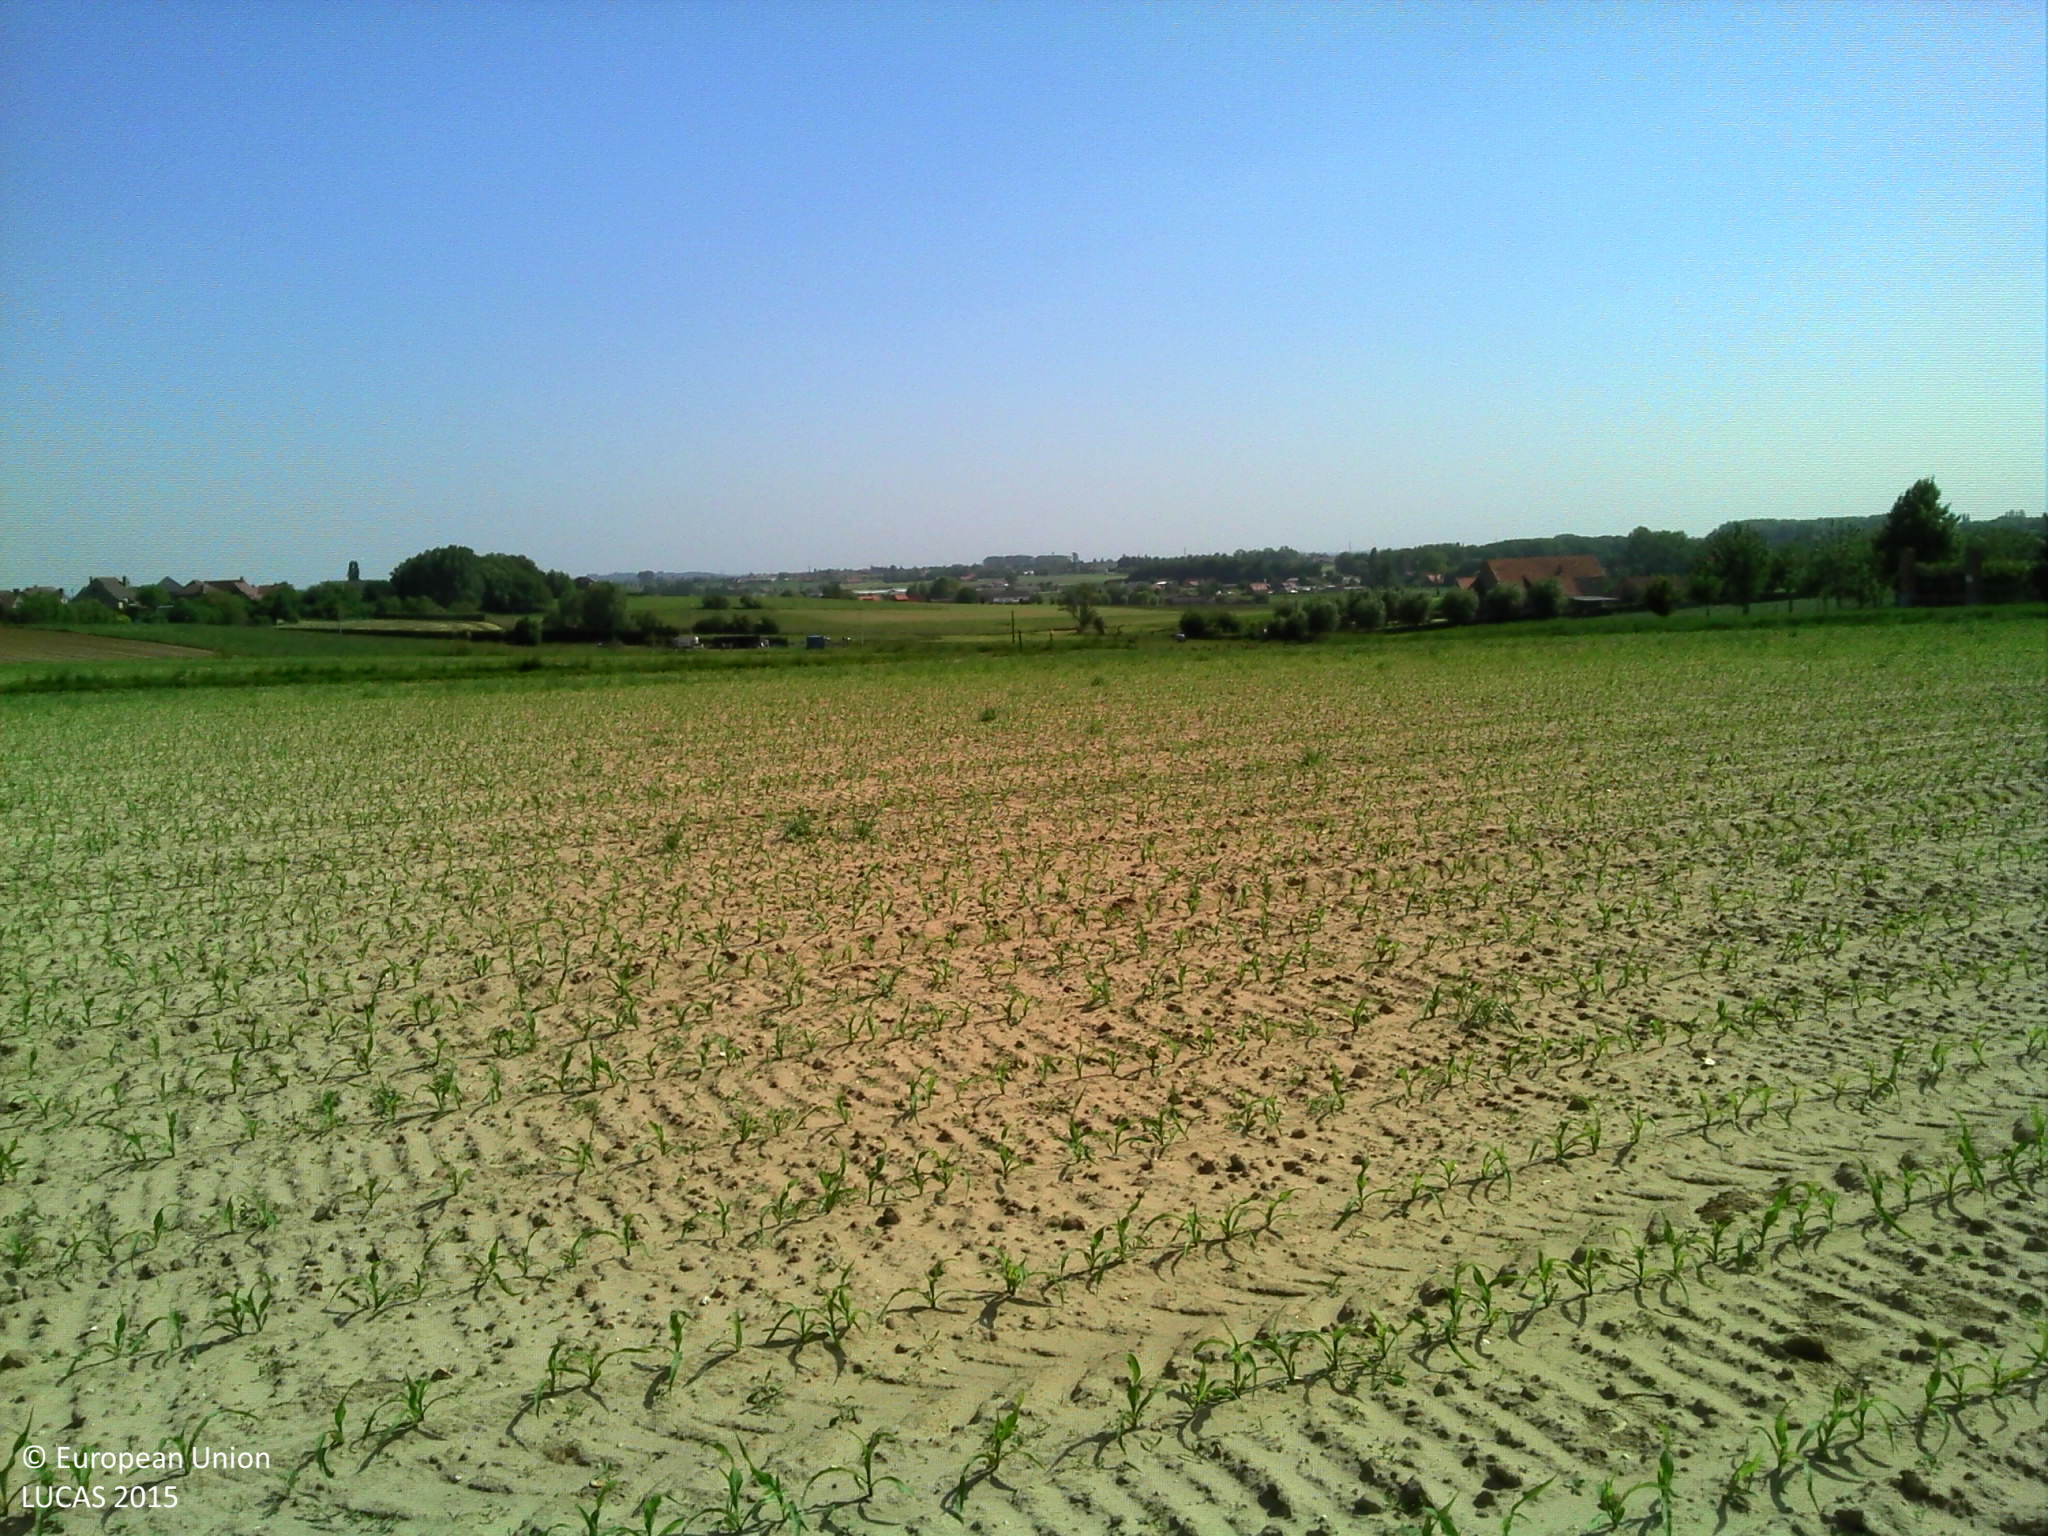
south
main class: Cropland
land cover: Maize
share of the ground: < 10 %
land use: Agriculture (excluding fallow land and kitchen gardens)
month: June
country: BE
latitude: 50.8543
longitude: 3.0152
